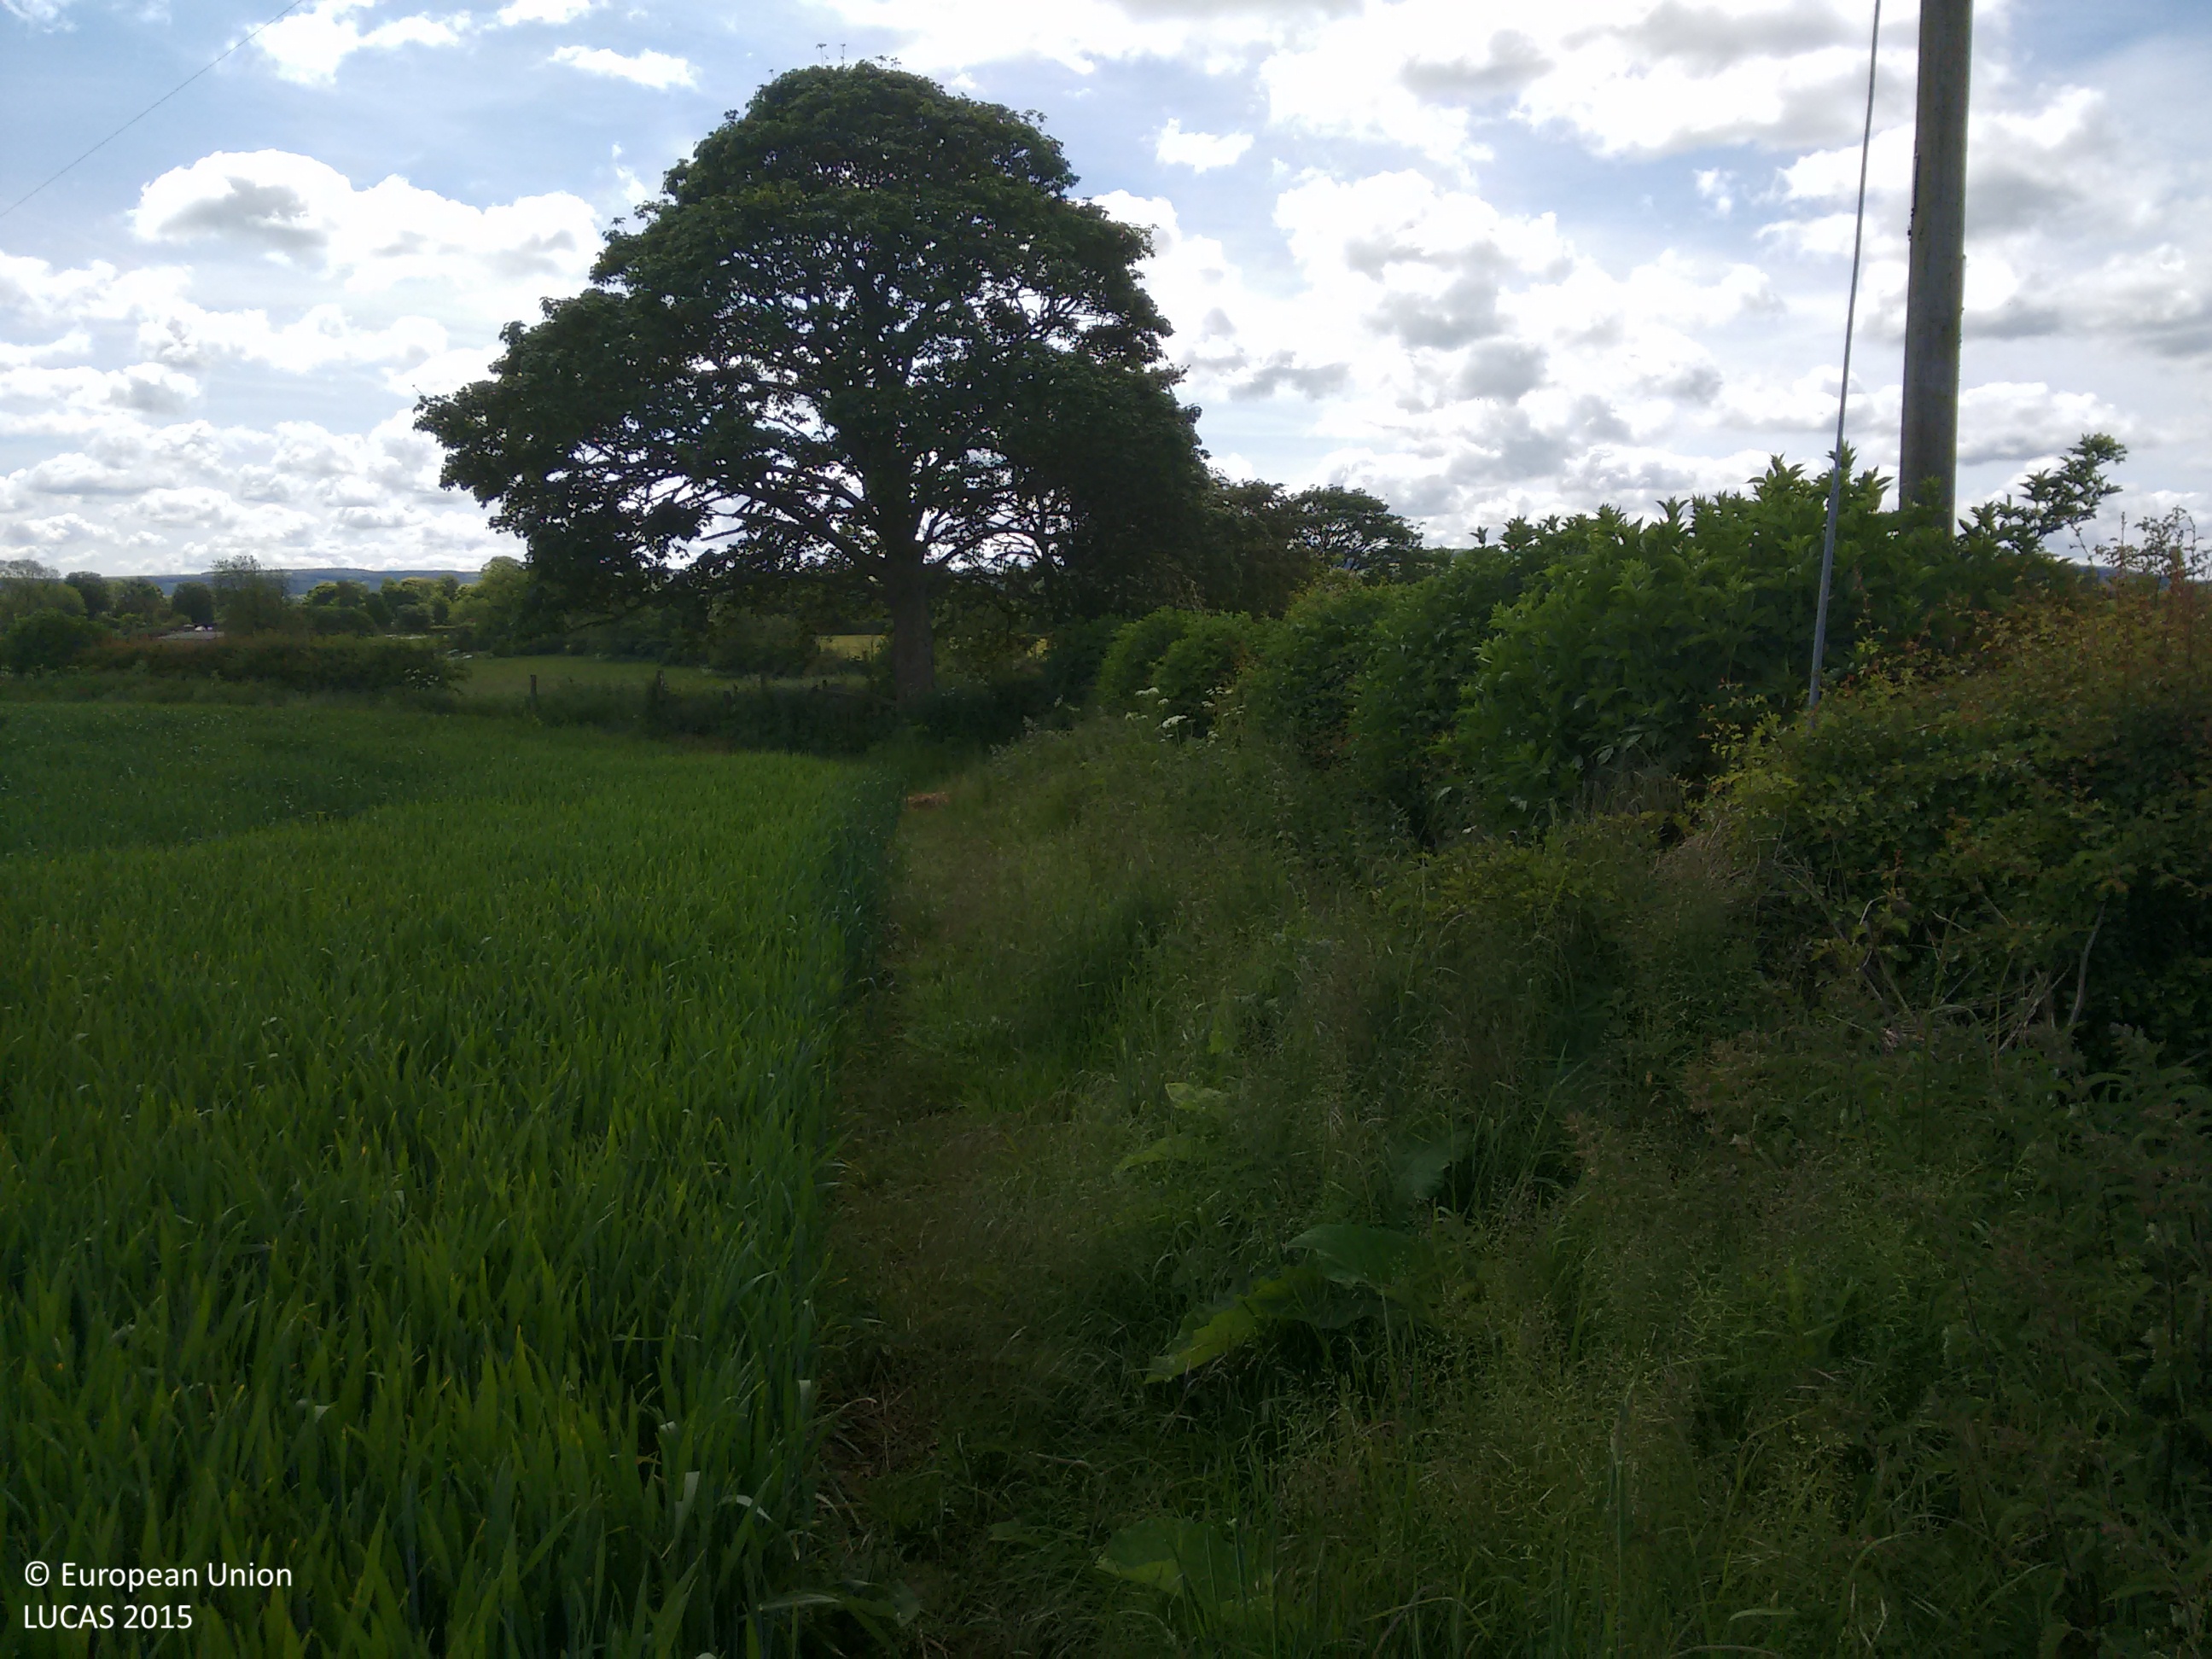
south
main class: Cropland
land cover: Common wheat
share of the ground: > 75 %
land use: Agriculture (excluding fallow land and kitchen gardens)
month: June
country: GB
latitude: 54.0978
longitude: -0.7898
